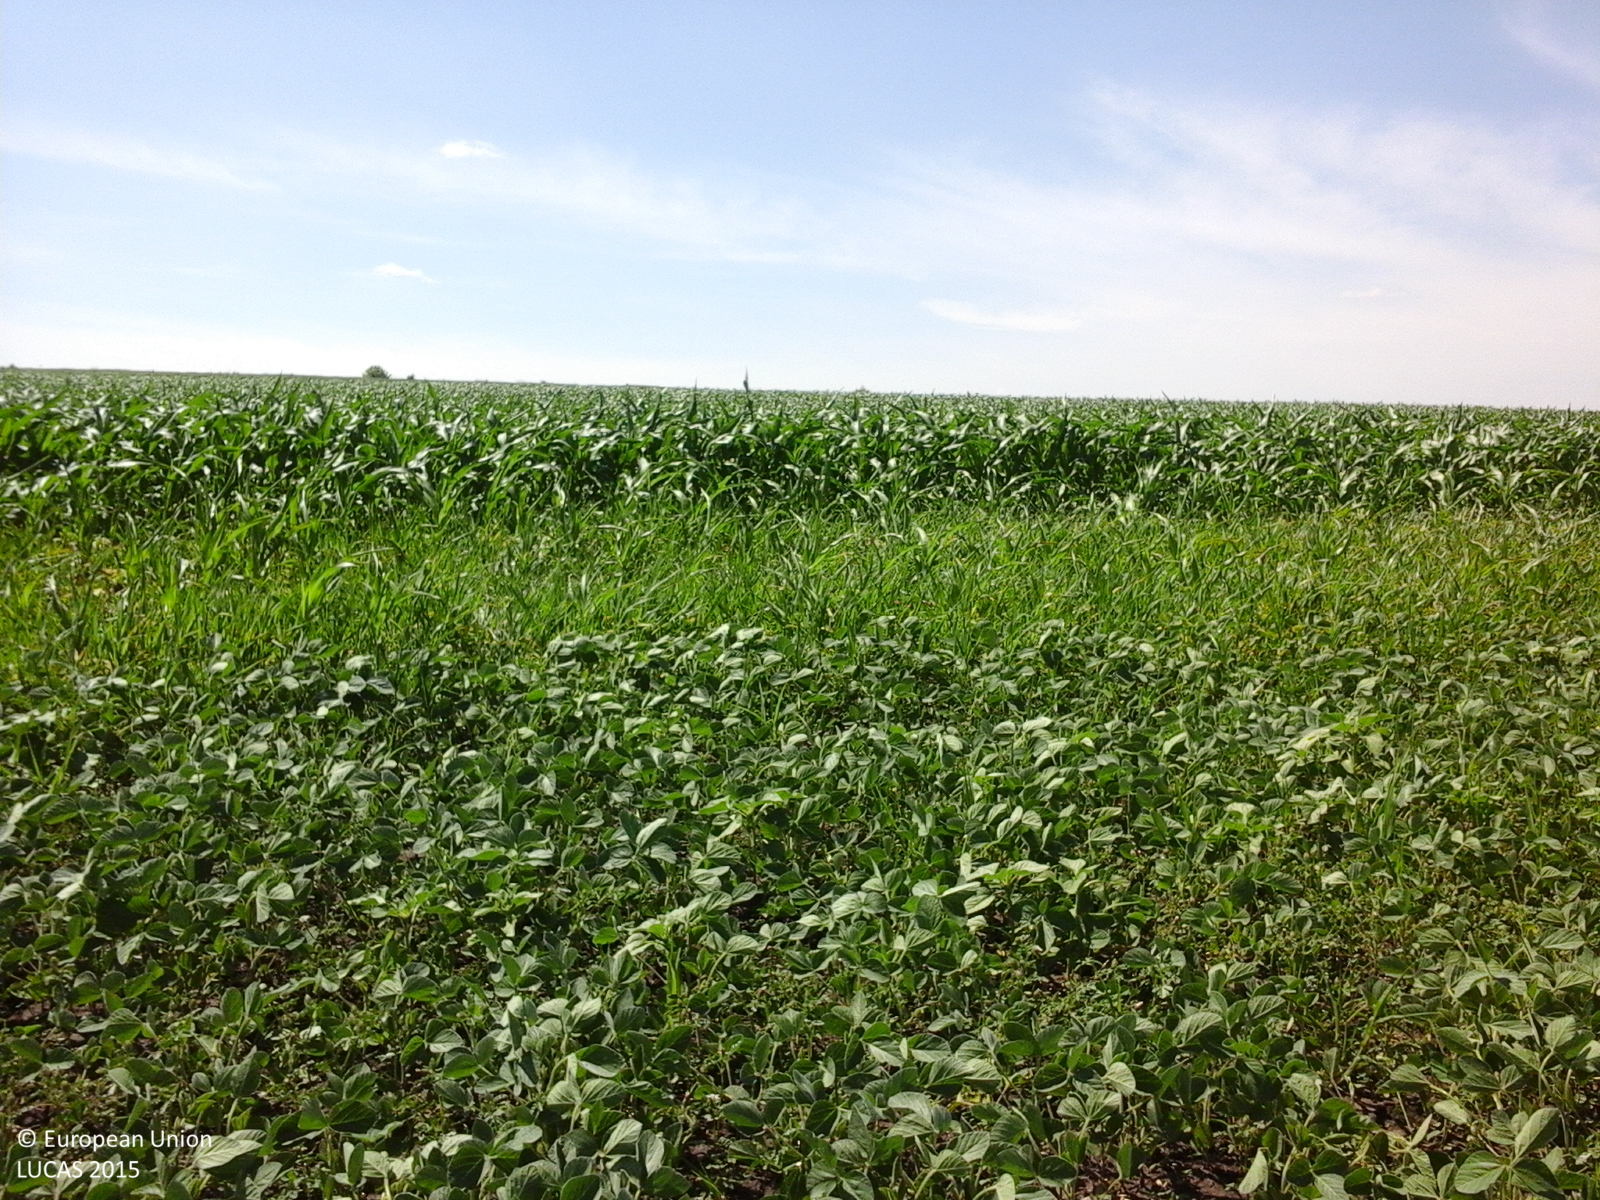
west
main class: Cropland
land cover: Soya
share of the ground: > 75 %
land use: Agriculture (excluding fallow land and kitchen gardens)
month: June
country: RO
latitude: 47.9545
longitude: 27.1298
